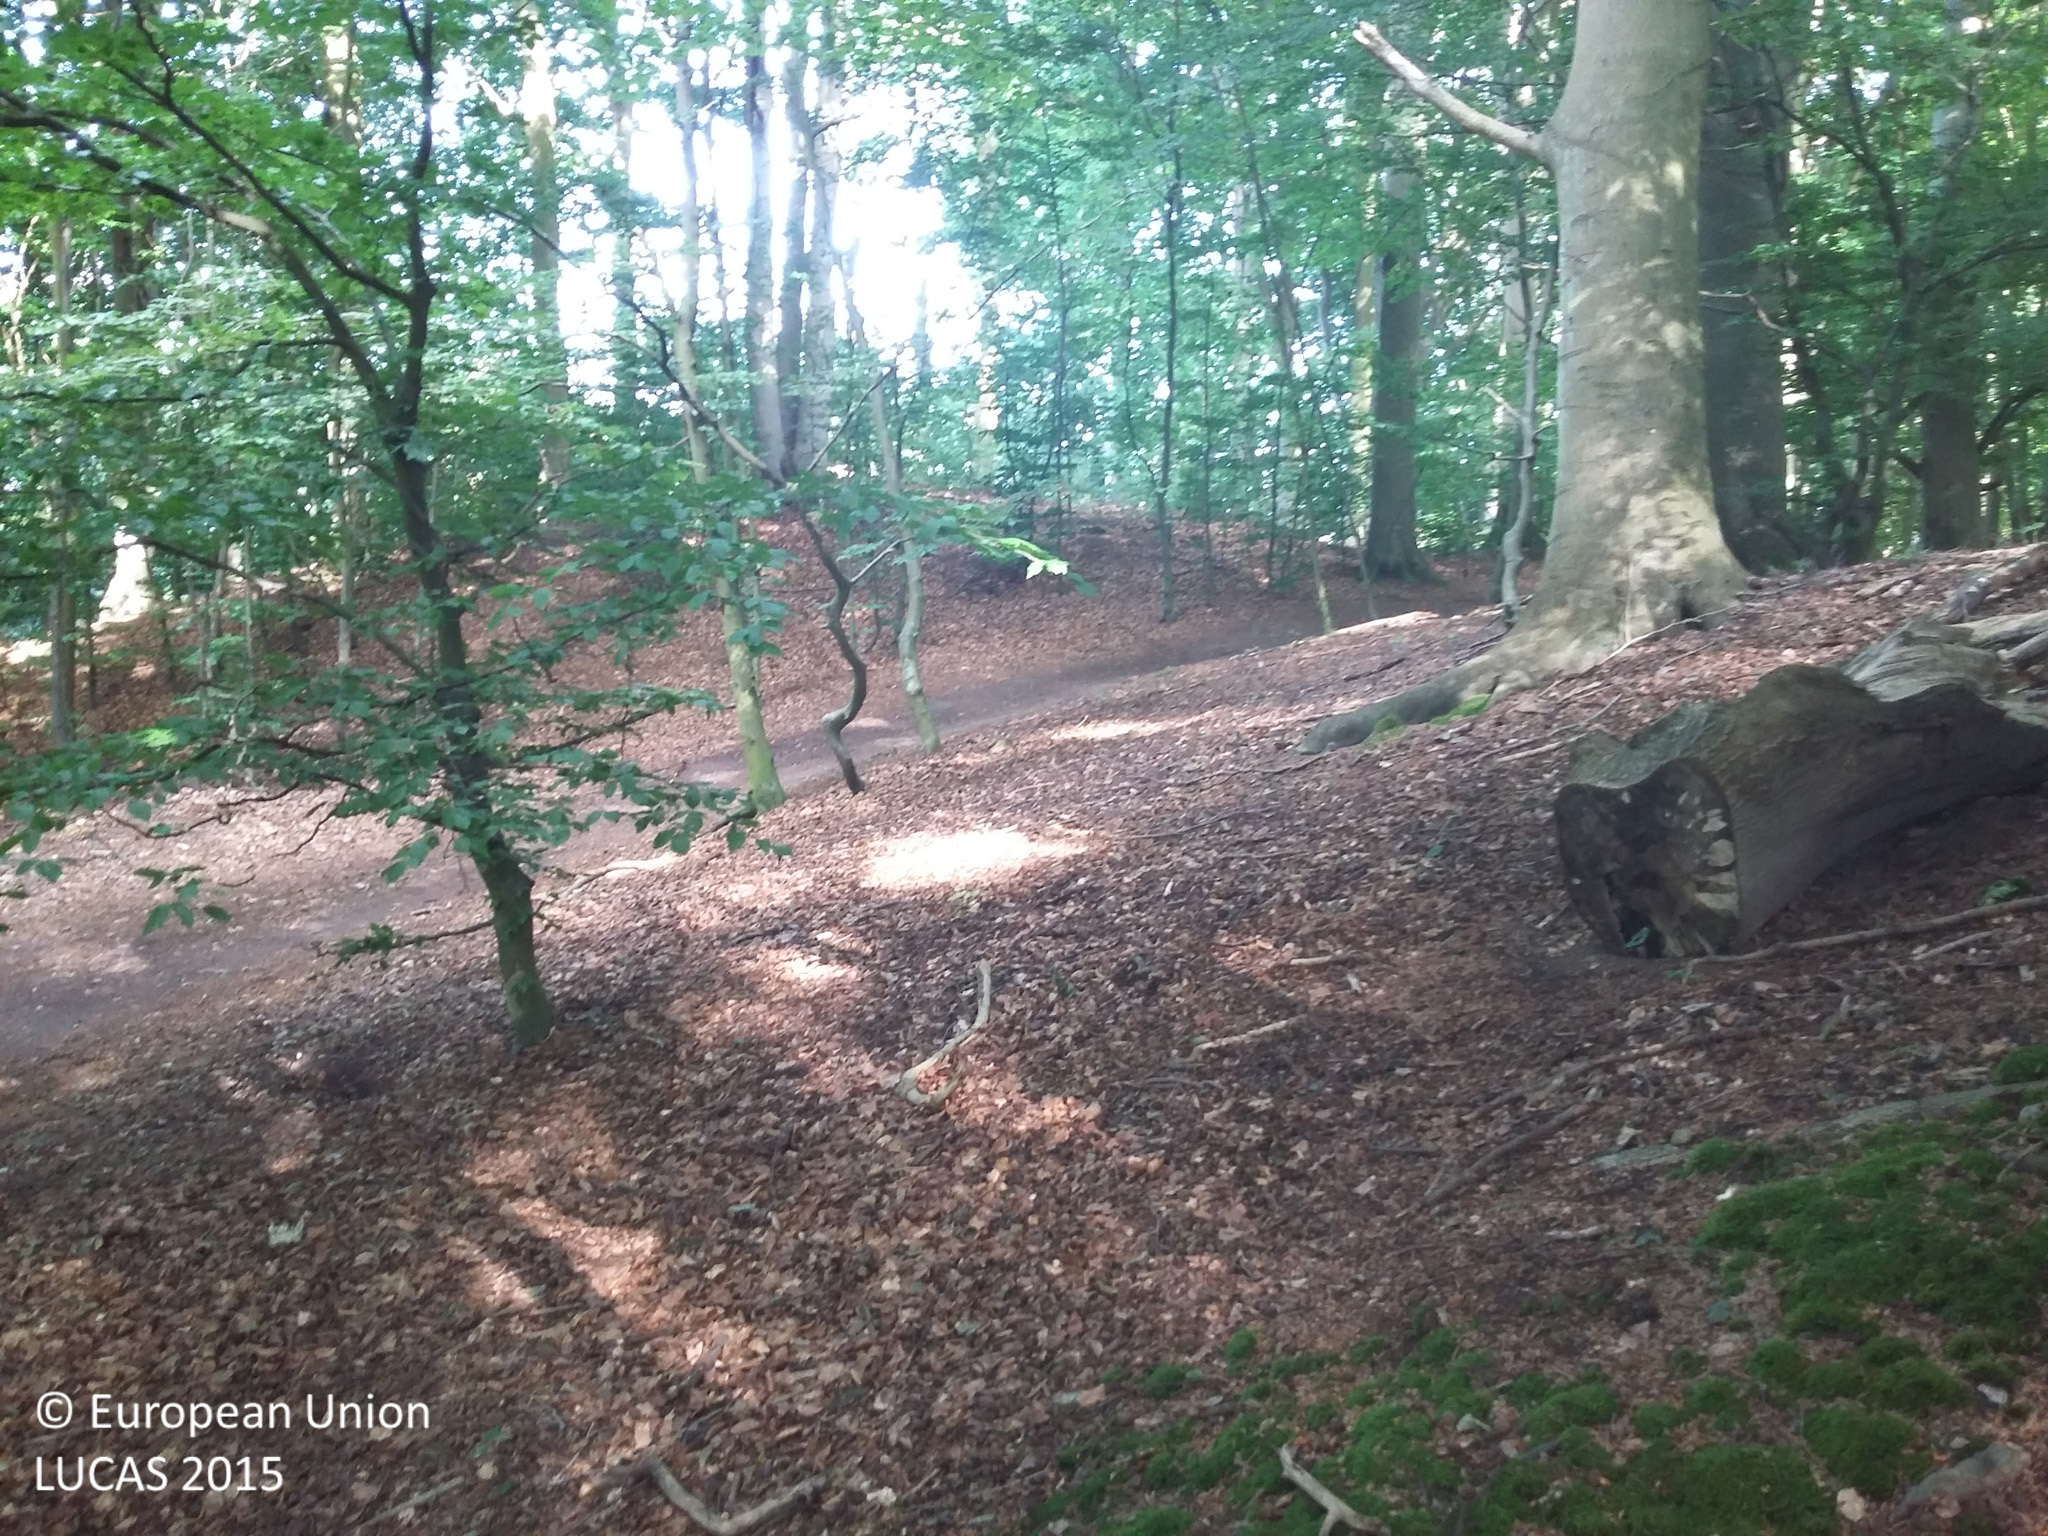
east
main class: Woodland
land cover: Broadleaved woodland
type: beech forest
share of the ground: > 75 %
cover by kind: broadleaved forest trees 95 %, herbaceous plants 5 %
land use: Amenities, museums, leisure
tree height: > 5 m
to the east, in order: Broadleaved woodland; Tracks; Broadleaved woodland; Railways; Shrubland with sparse tree cover; Artificial constructions in urban areas
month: July
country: DK
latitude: 56.0539
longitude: 12.5829
